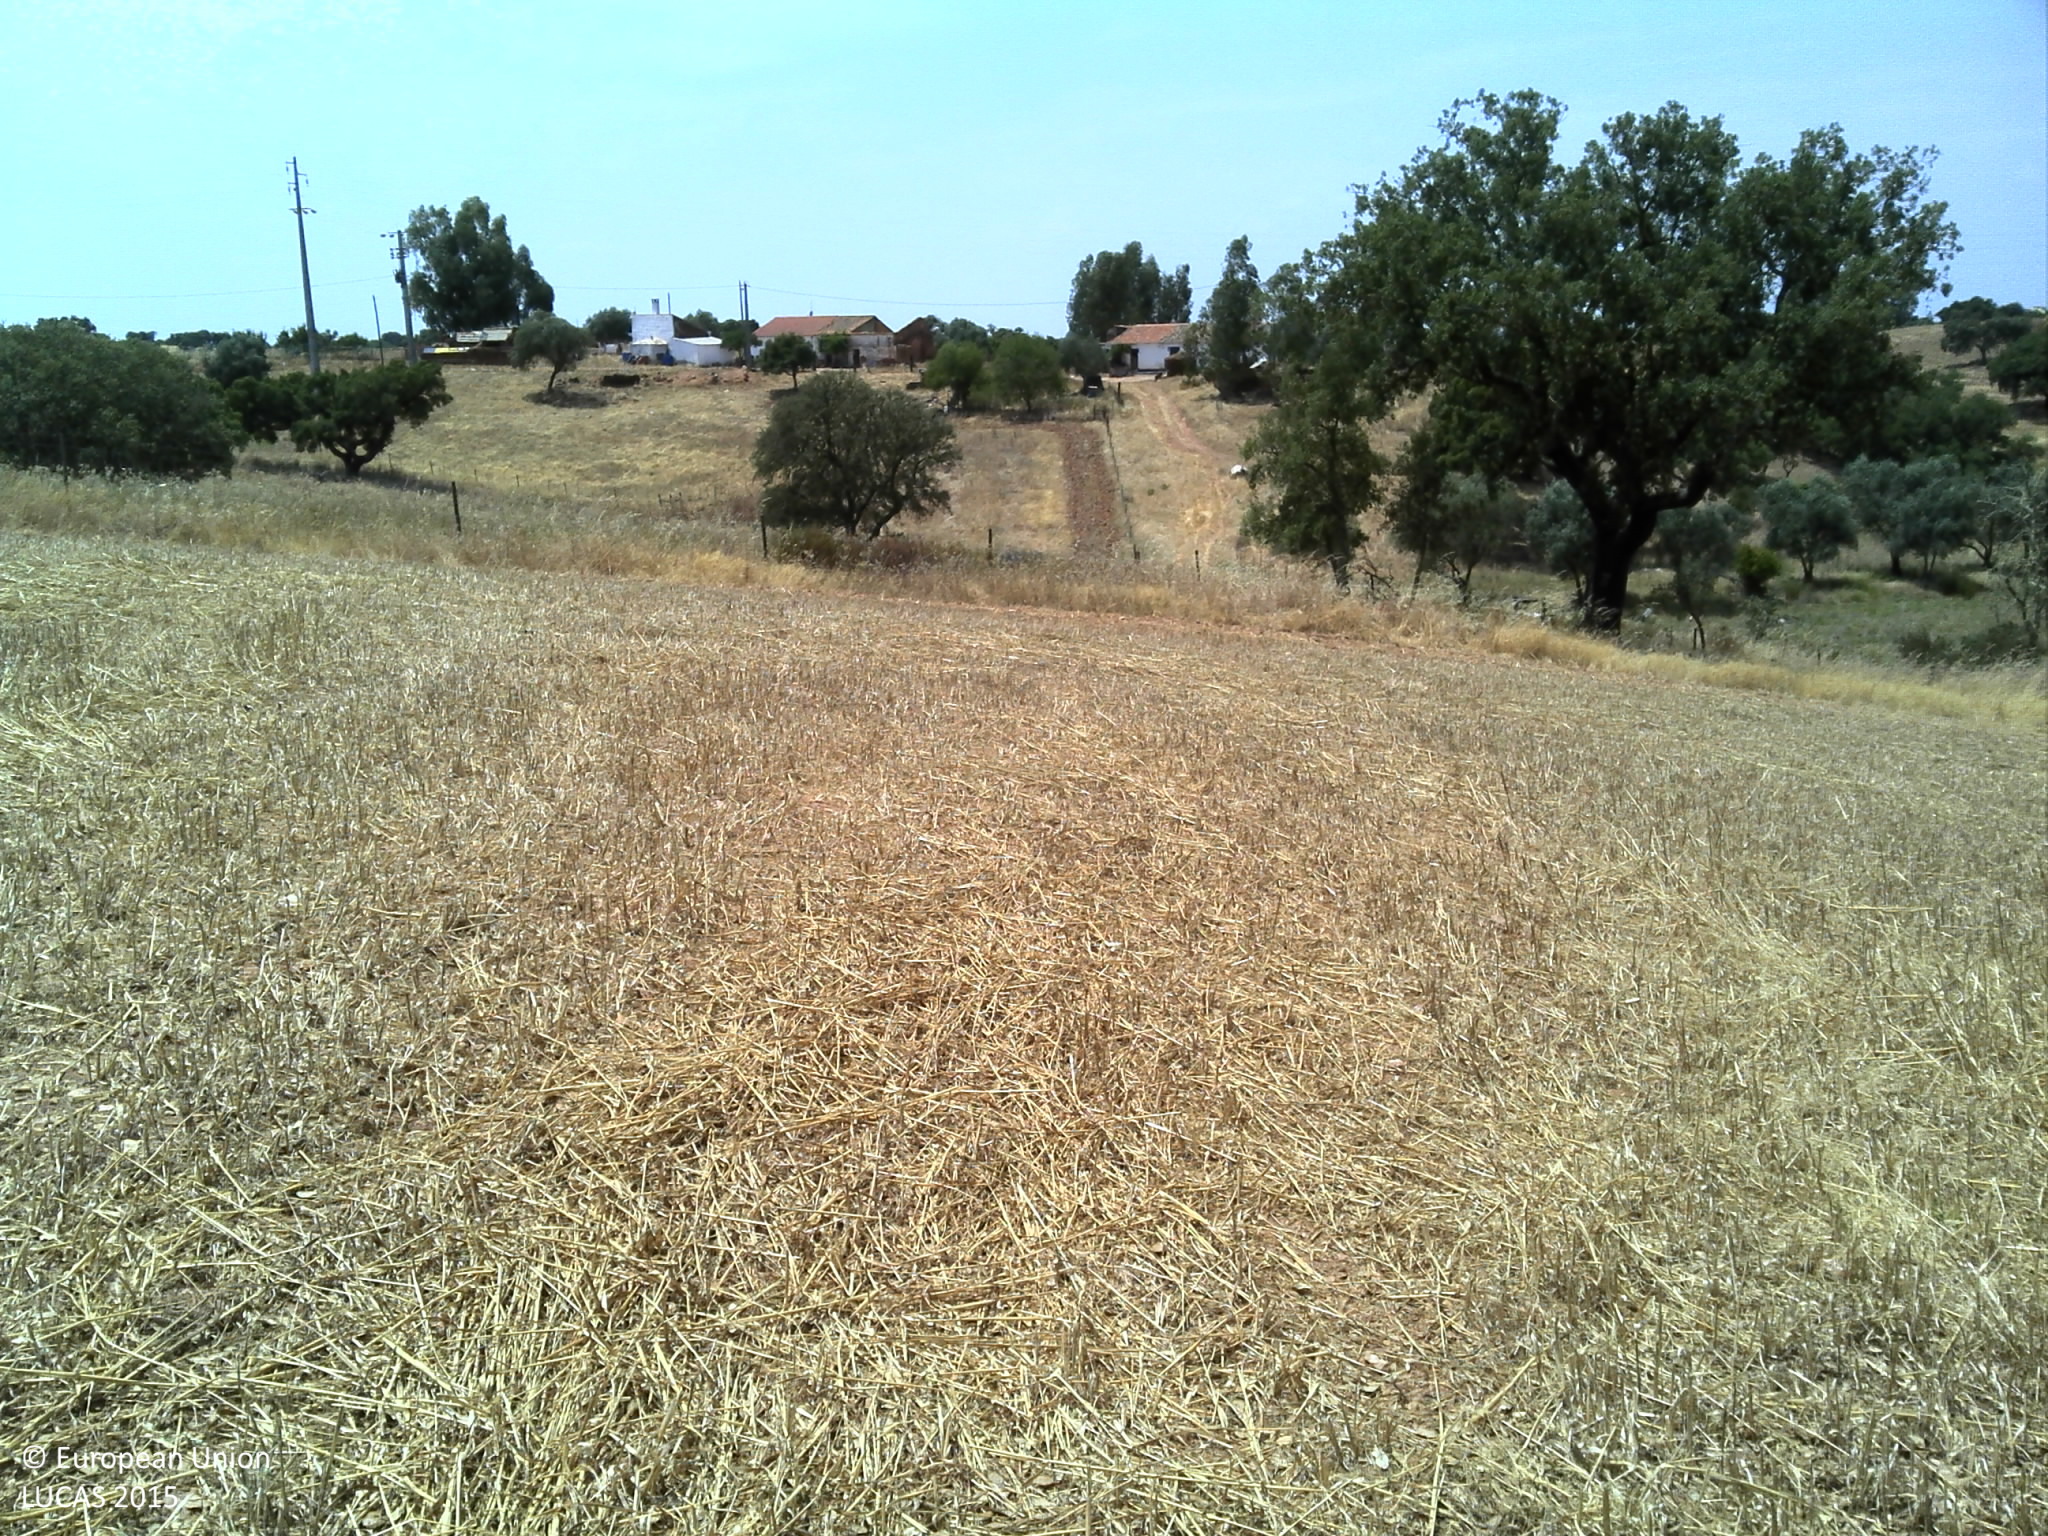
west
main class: Woodland
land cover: Broadleaved woodland
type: thermophilous deciduous forest
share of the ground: 25 - 50 %
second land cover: Grassland without tree/shrub cover
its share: 50 - 75 %
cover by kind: herbaceous plants 60 %, broadleaved forest trees 30 %, unconsolidated bare surface 10 %
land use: Forestry
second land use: Agriculture (excluding fallow land and kitchen gardens)
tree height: > 5 m
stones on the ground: < 10 %
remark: Harvested field
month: June
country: PT
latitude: 37.7694
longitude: -7.5322
